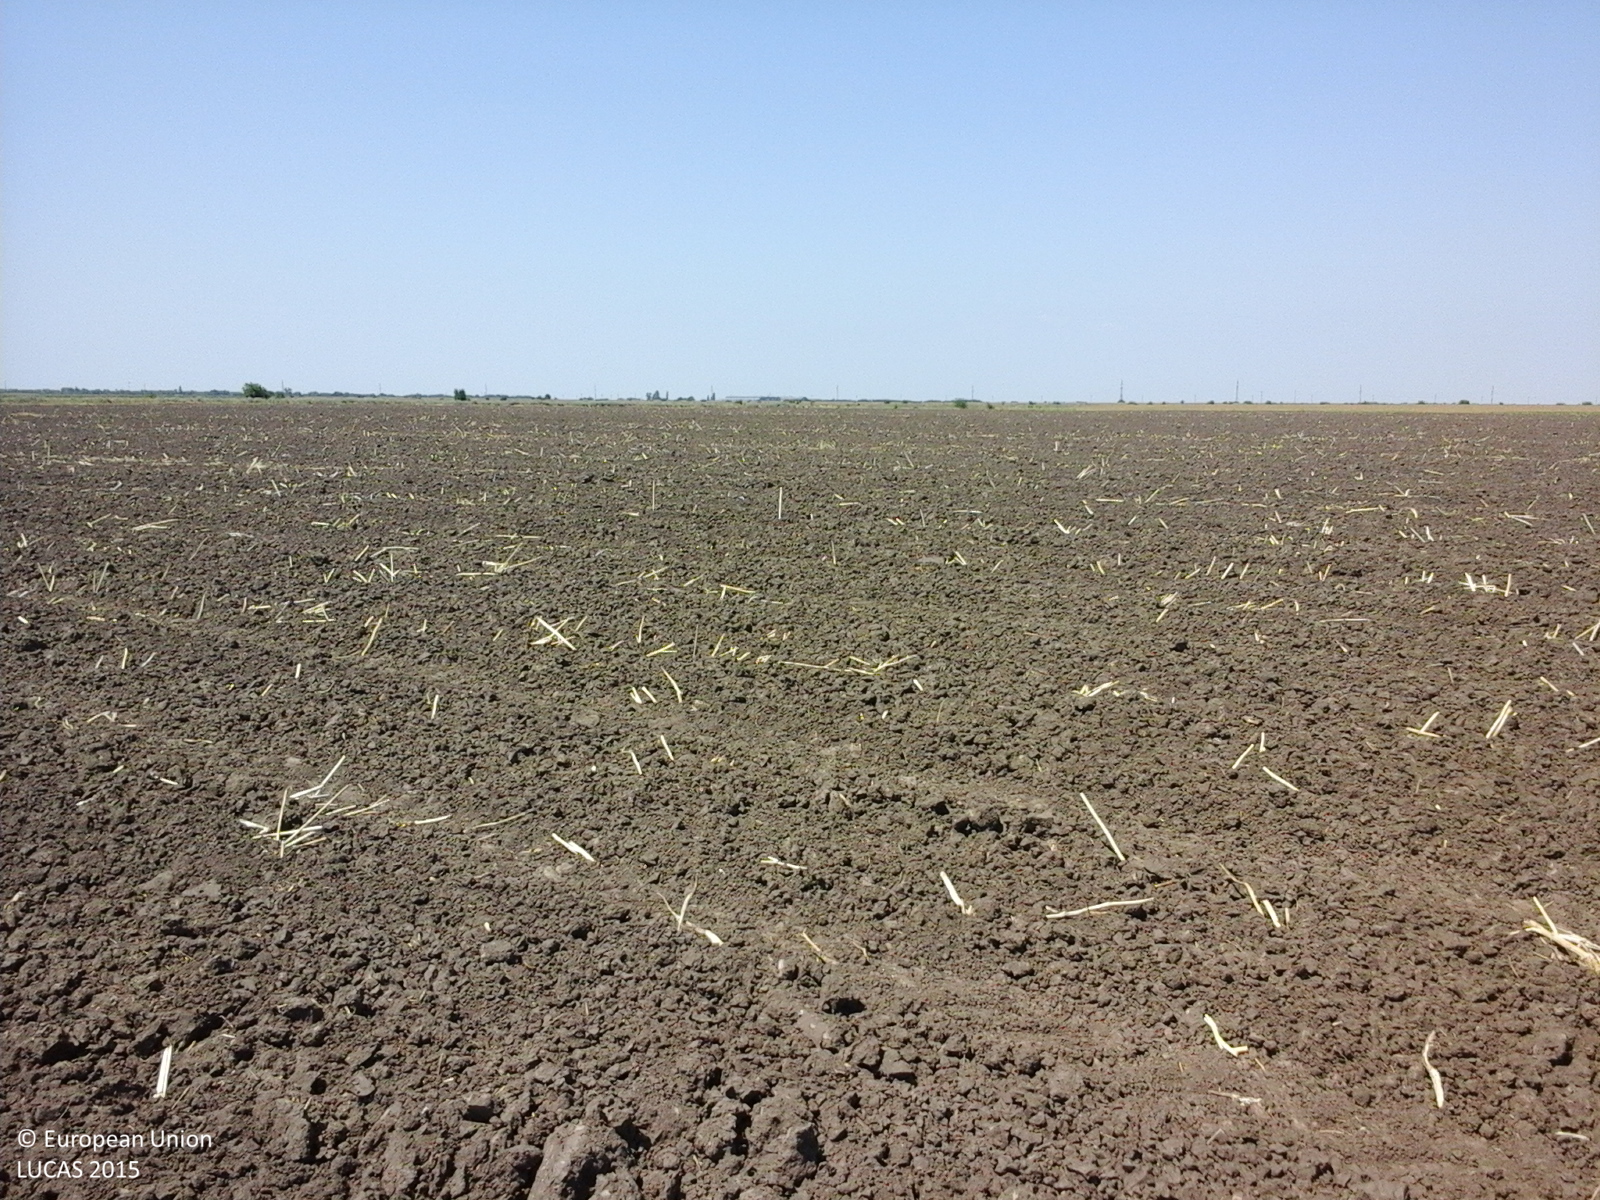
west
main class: Cropland
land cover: Rape and turnip rape
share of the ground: < 10 %
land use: Agriculture (excluding fallow land and kitchen gardens)
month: July
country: RO
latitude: 44.2965
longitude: 27.1125
